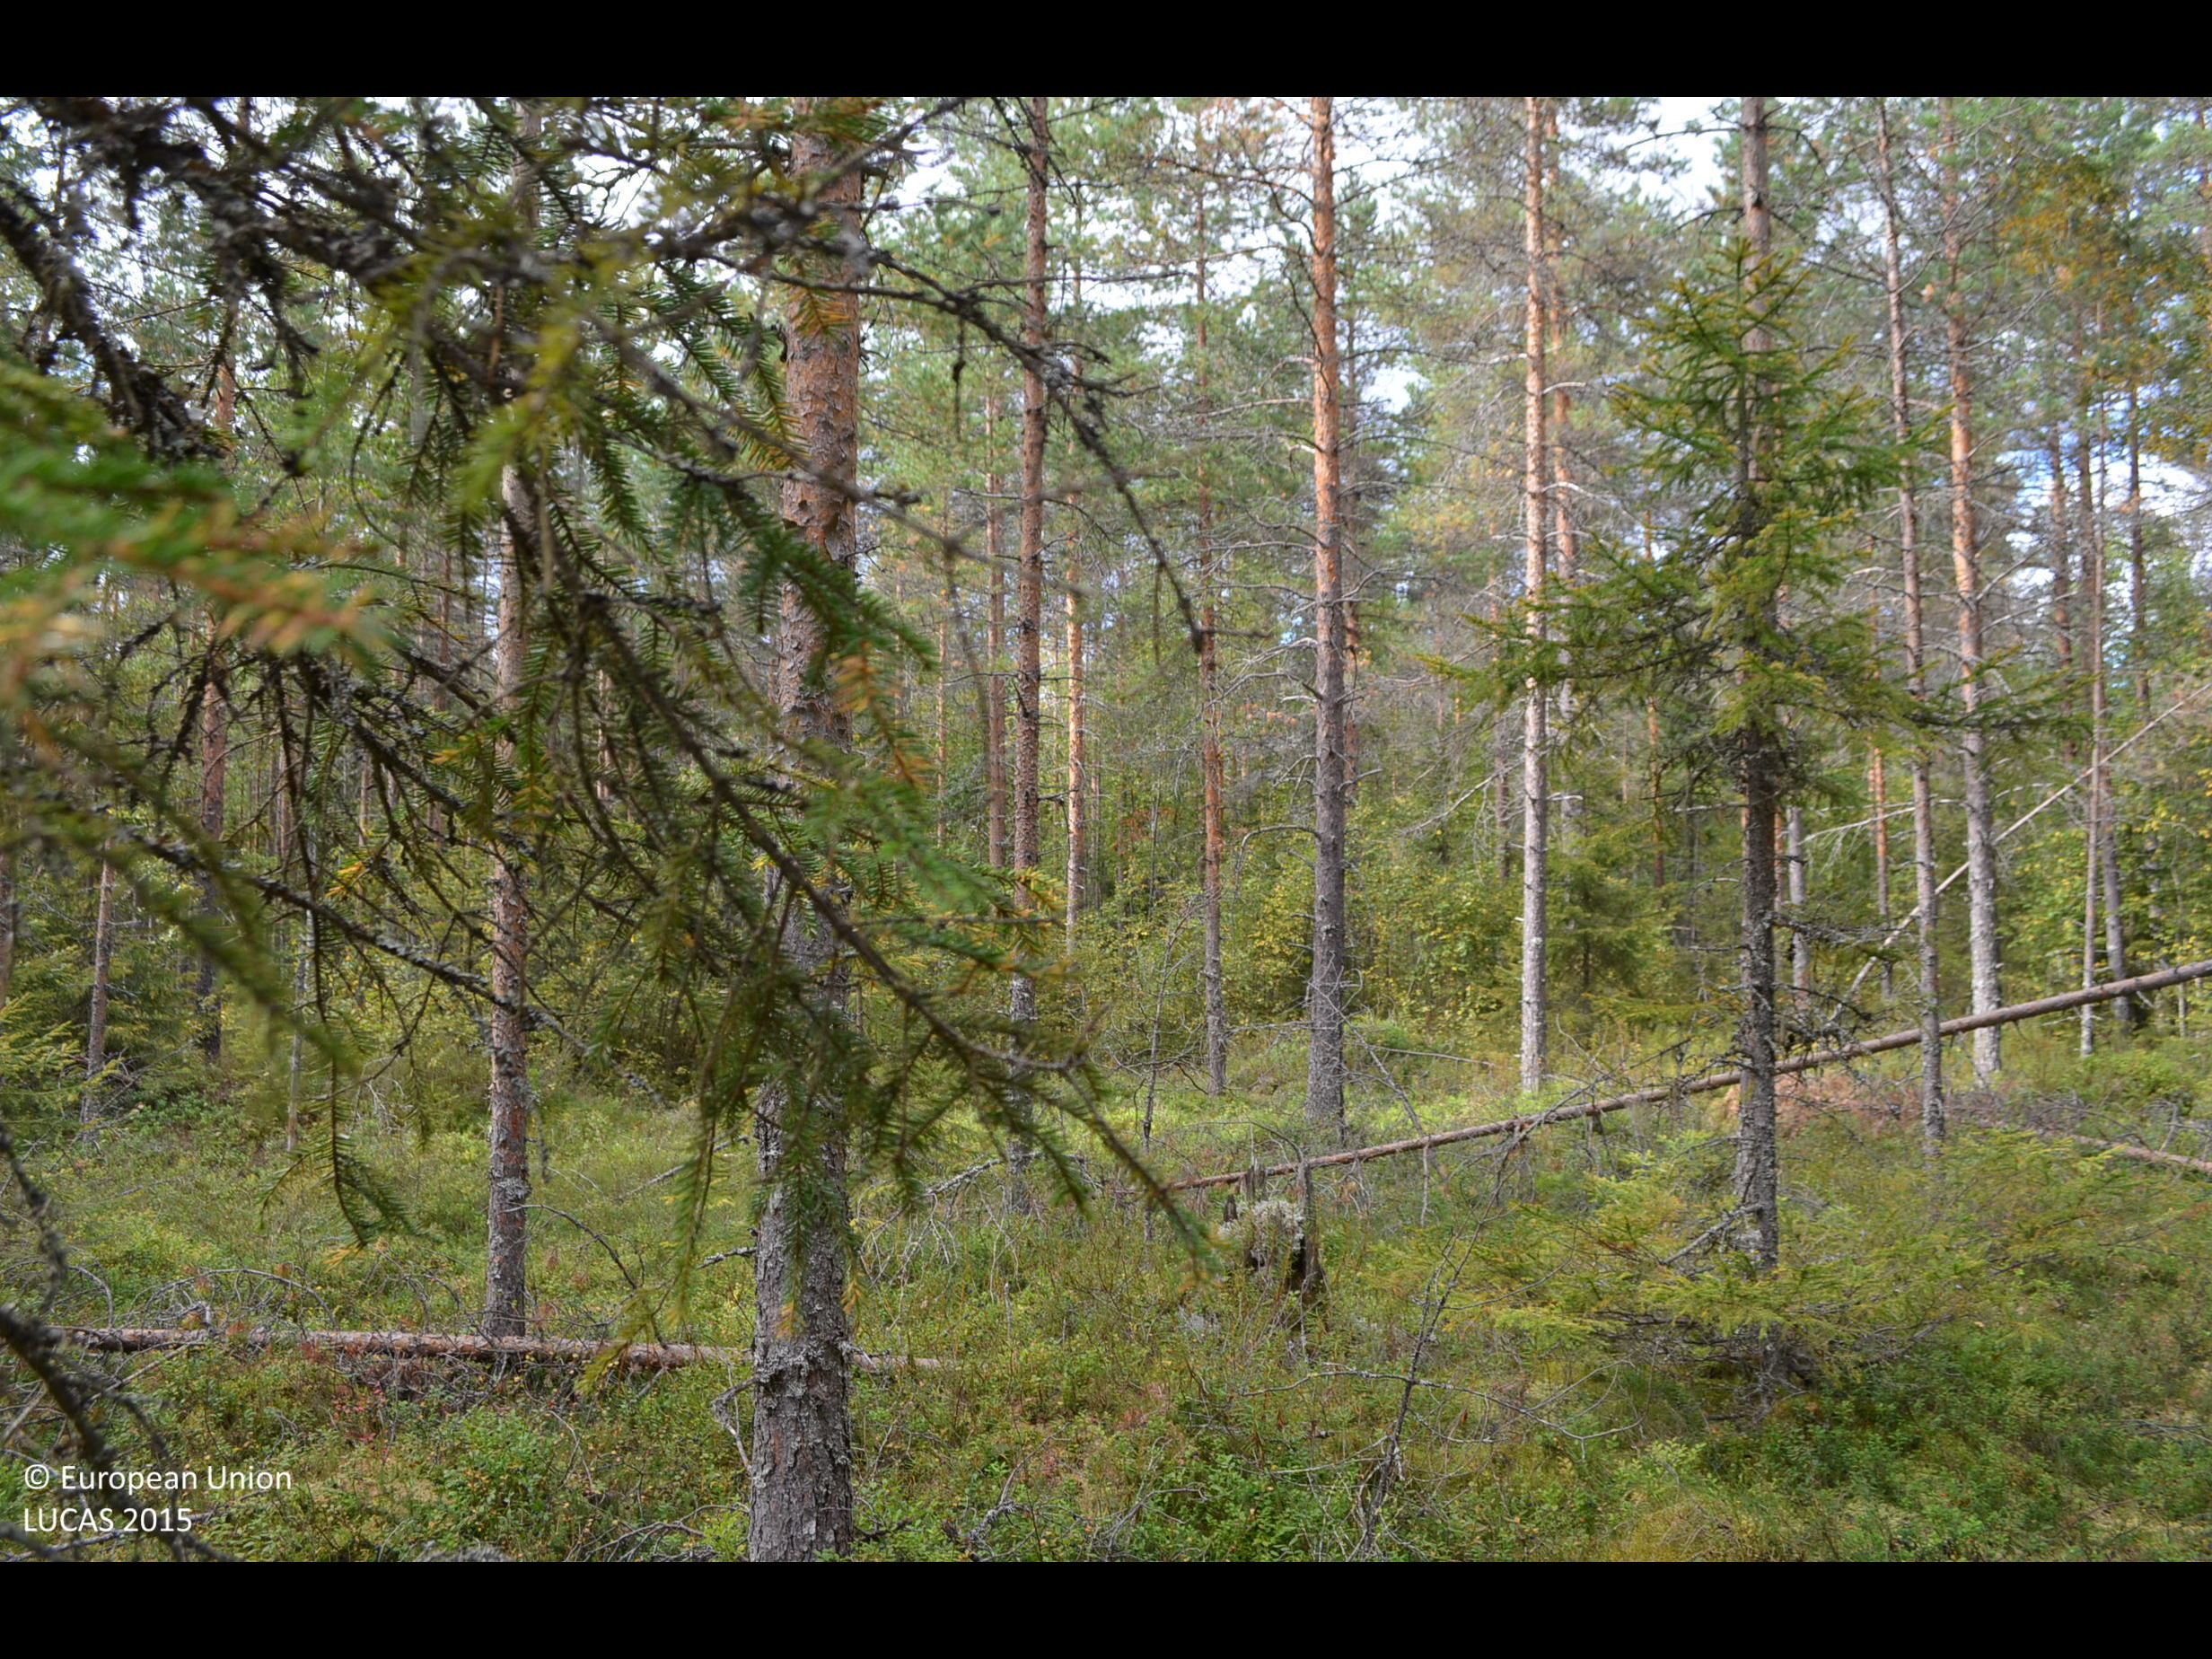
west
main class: Woodland
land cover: Pine dominated mixed woodland
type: boreal forest
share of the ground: > 75 %
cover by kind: coniferous forest trees 55 %, broadleaved forest trees 20 %, shrubs 20 %, lichens and mosses 5 %
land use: Forestry
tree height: > 5 m
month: September
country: FI
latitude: 62.7045
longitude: 24.4136
